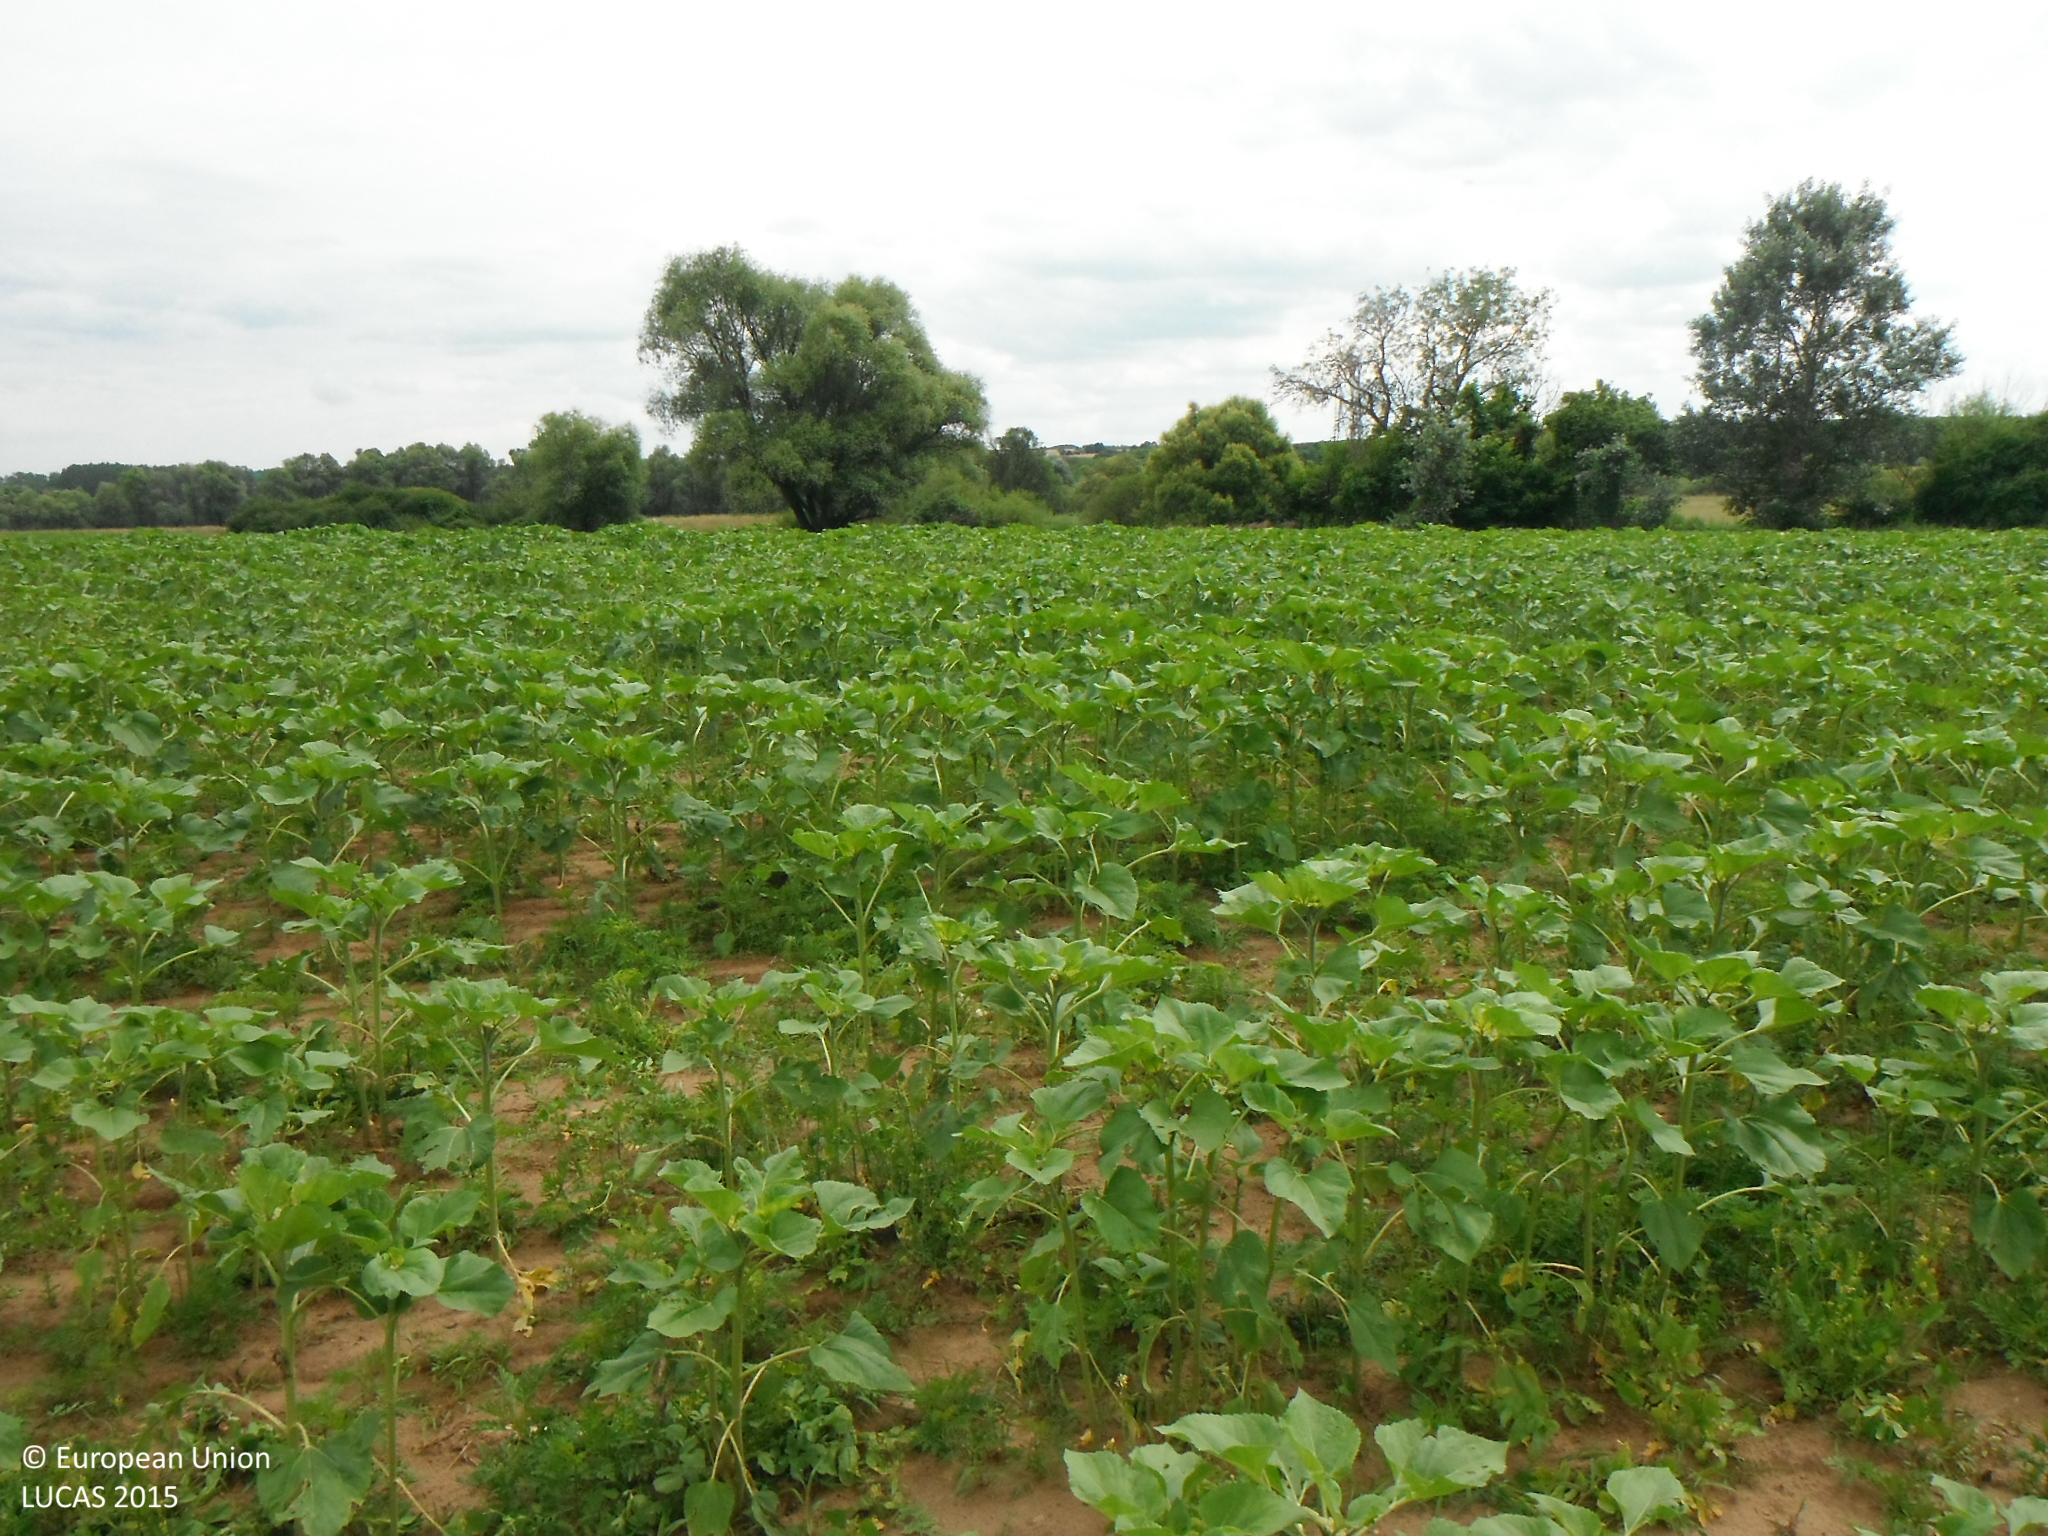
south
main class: Cropland
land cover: Sunflower
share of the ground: 50 - 75 %
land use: Agriculture (excluding fallow land and kitchen gardens)
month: June
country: SK
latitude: 48.0876
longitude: 19.4612
